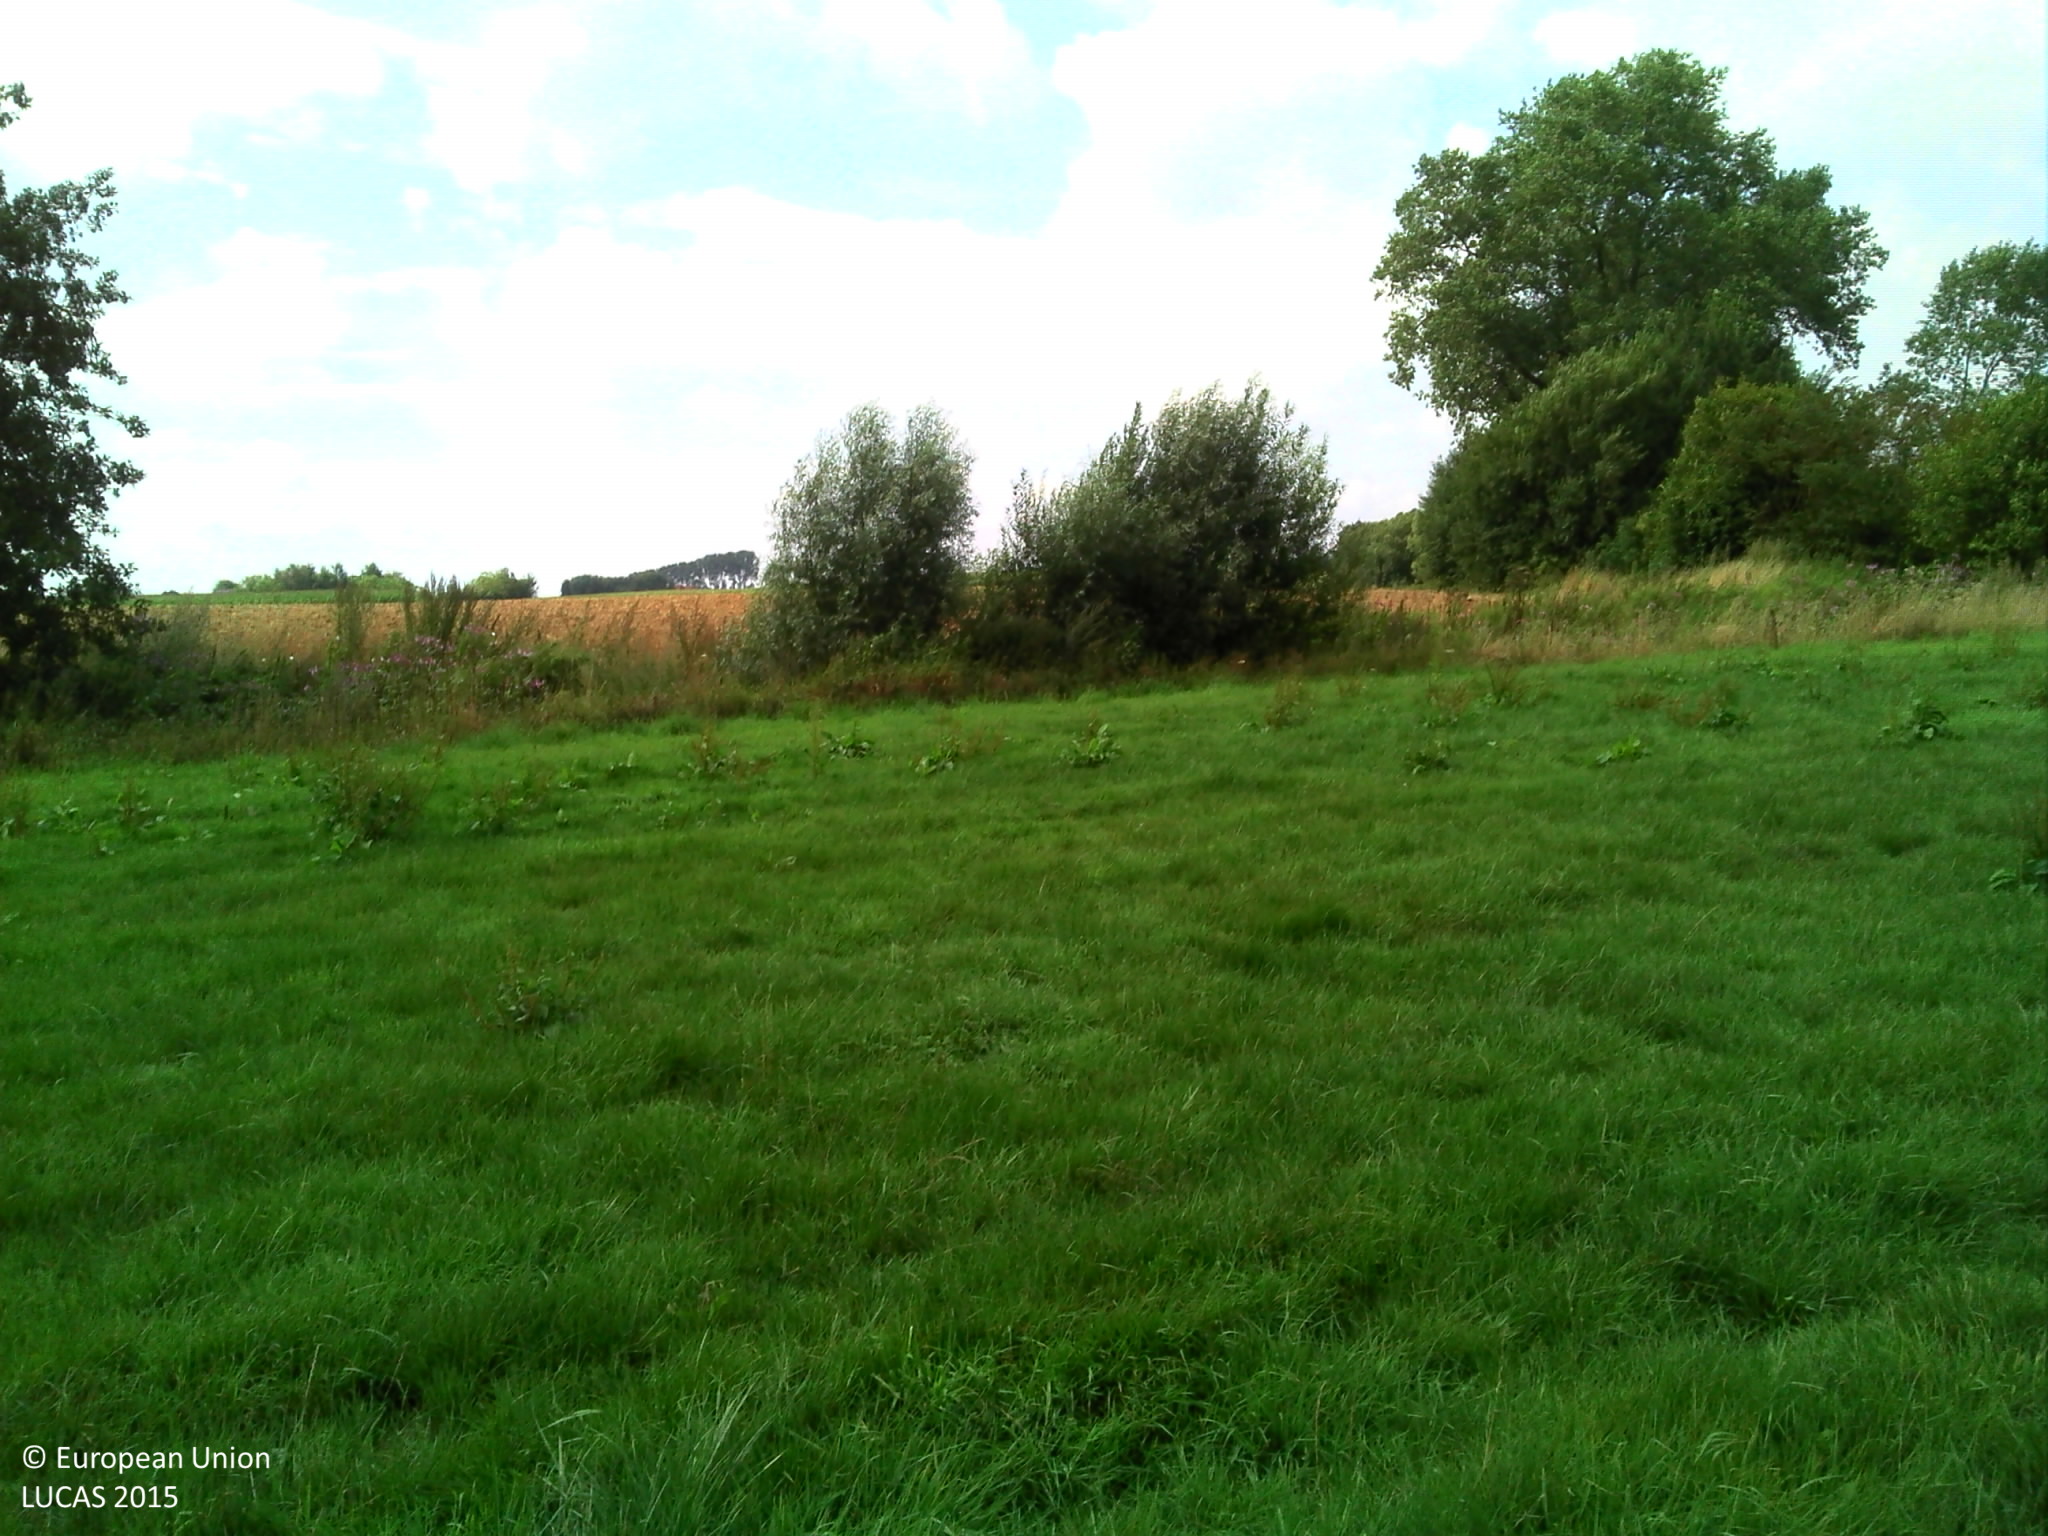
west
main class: Grassland
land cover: Grassland without tree/shrub cover
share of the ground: > 75 %
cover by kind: herbaceous plants 100 %
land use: Agriculture (excluding fallow land and kitchen gardens)
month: August
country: BE
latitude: 50.7671
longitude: 2.7718
